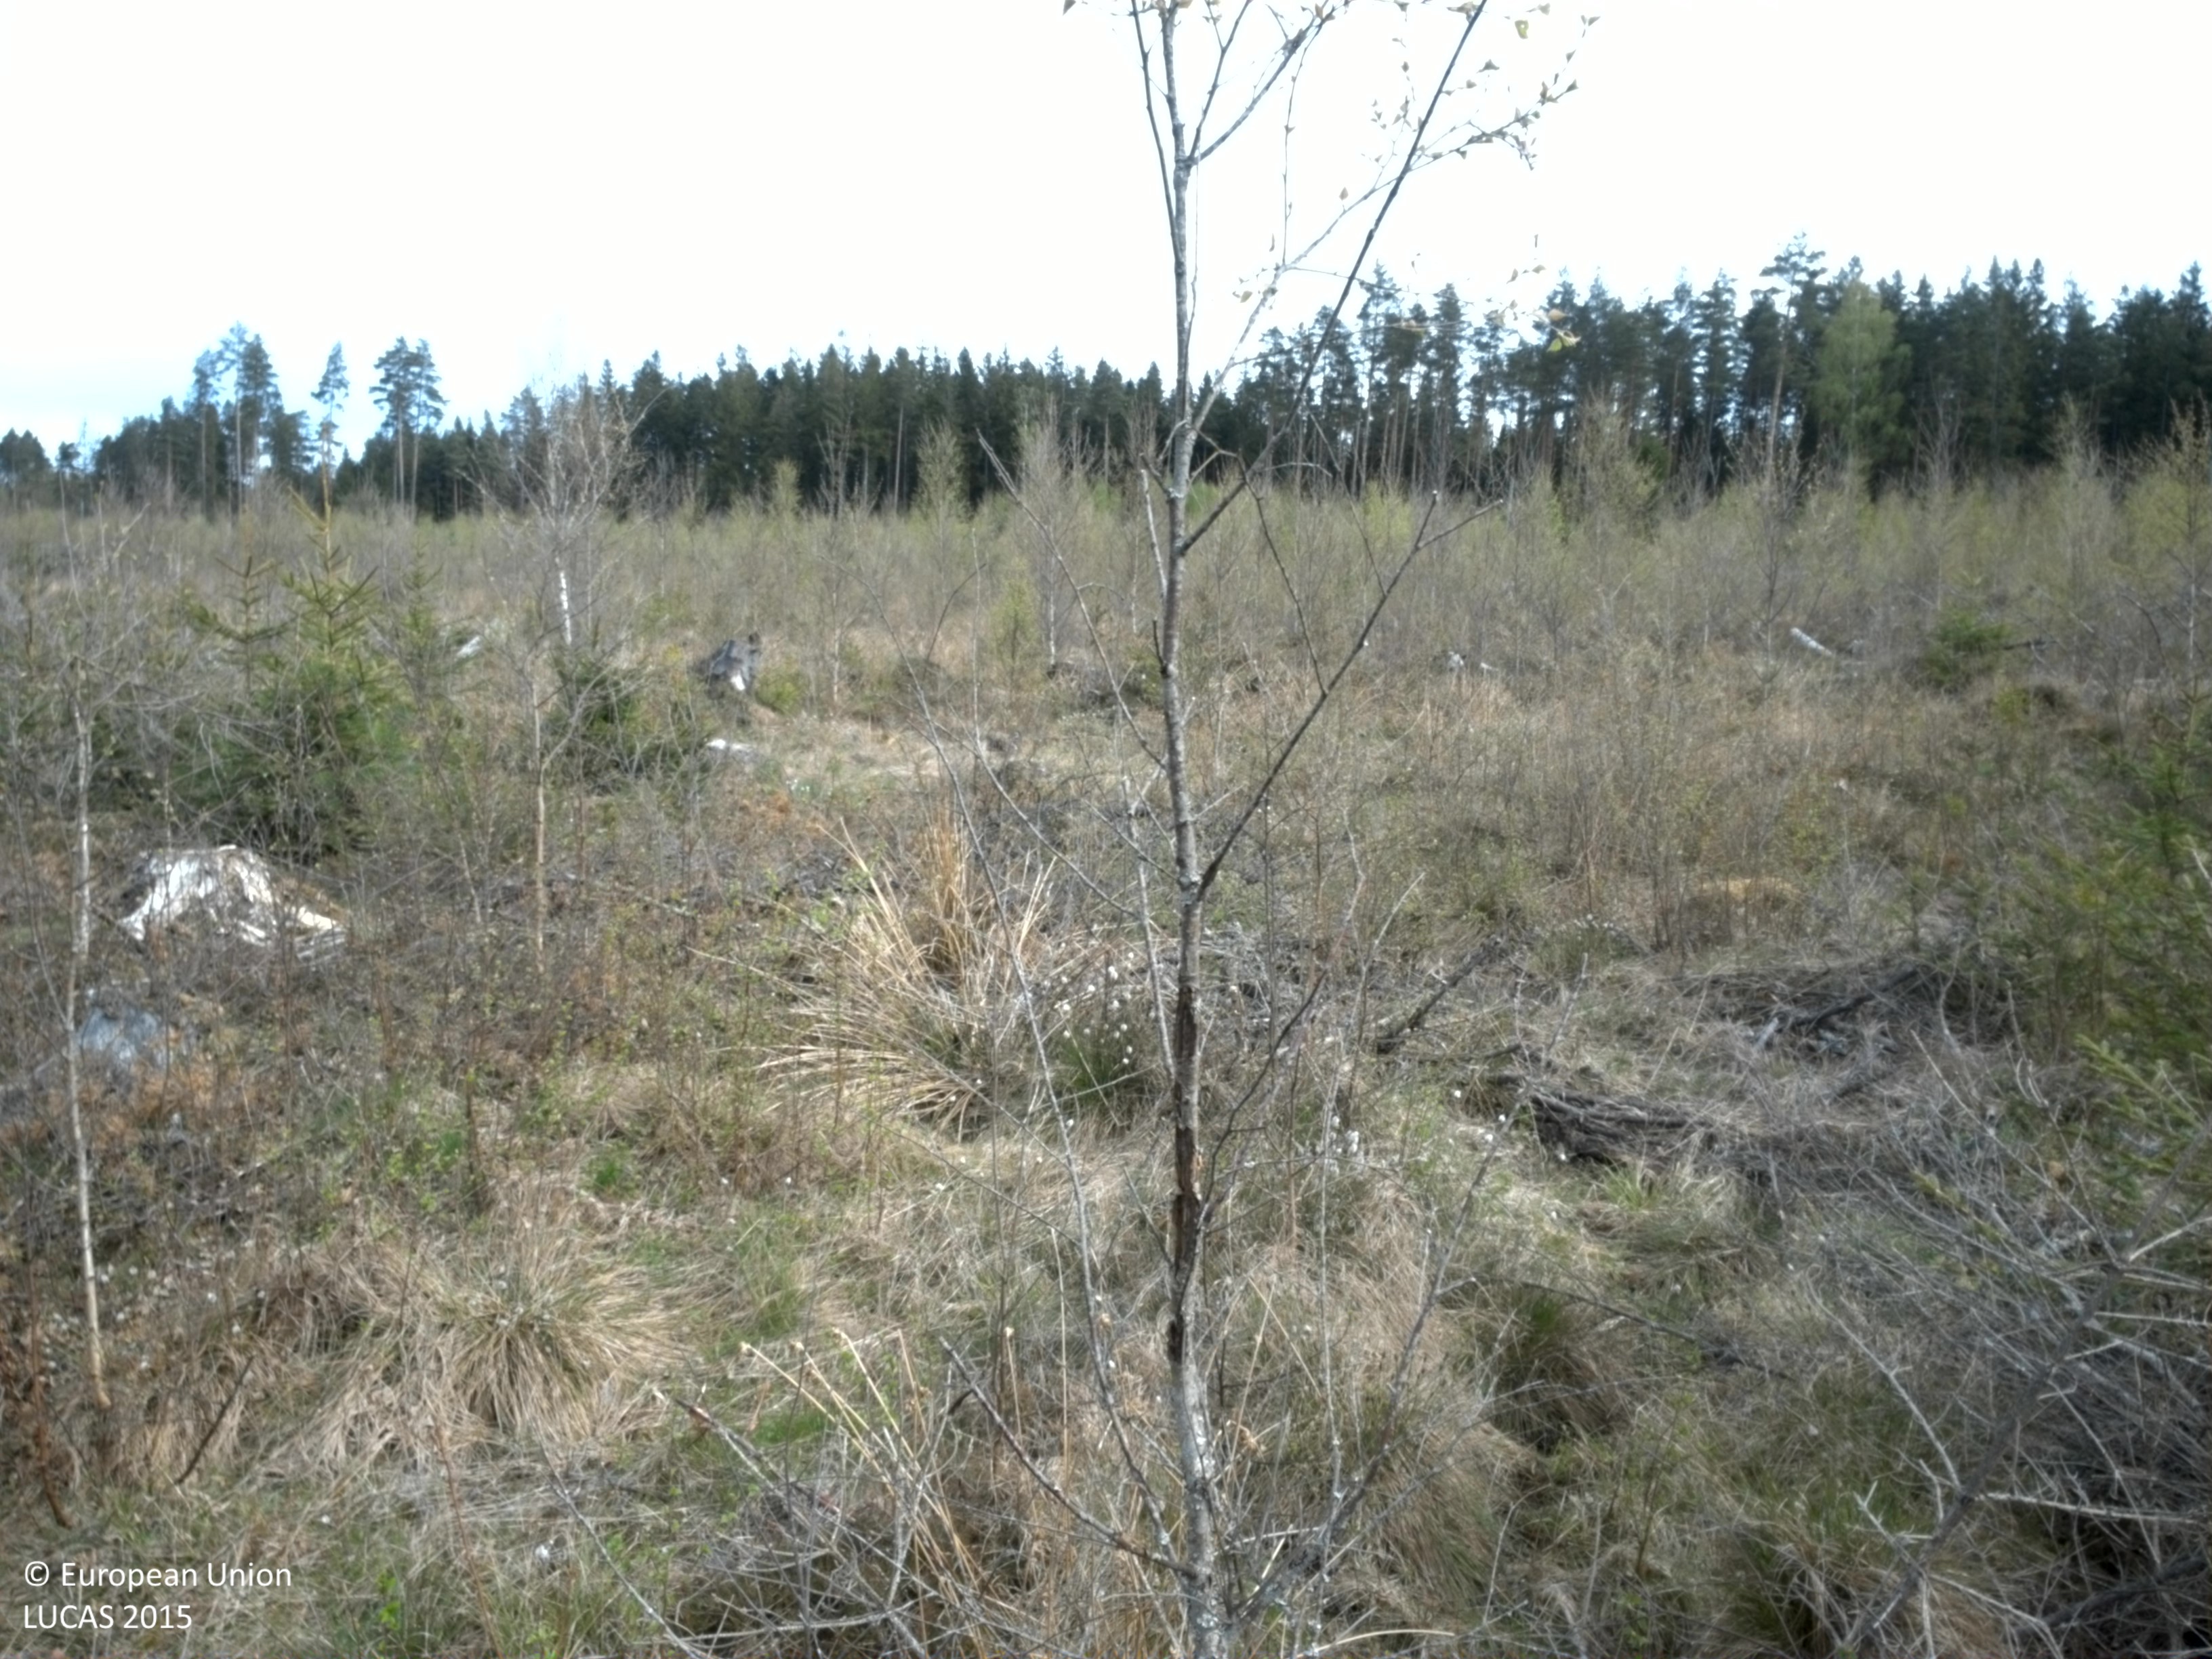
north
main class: Woodland
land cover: Spruce dominated coniferous woodland
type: boreal forest
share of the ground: > 75 %
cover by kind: coniferous forest trees 65 %, herbaceous plants 15 %, broadleaved forest trees 10 %, shrubs 10 %
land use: Forestry
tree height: < 5 m
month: May
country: SE
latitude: 56.8019
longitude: 14.7626
